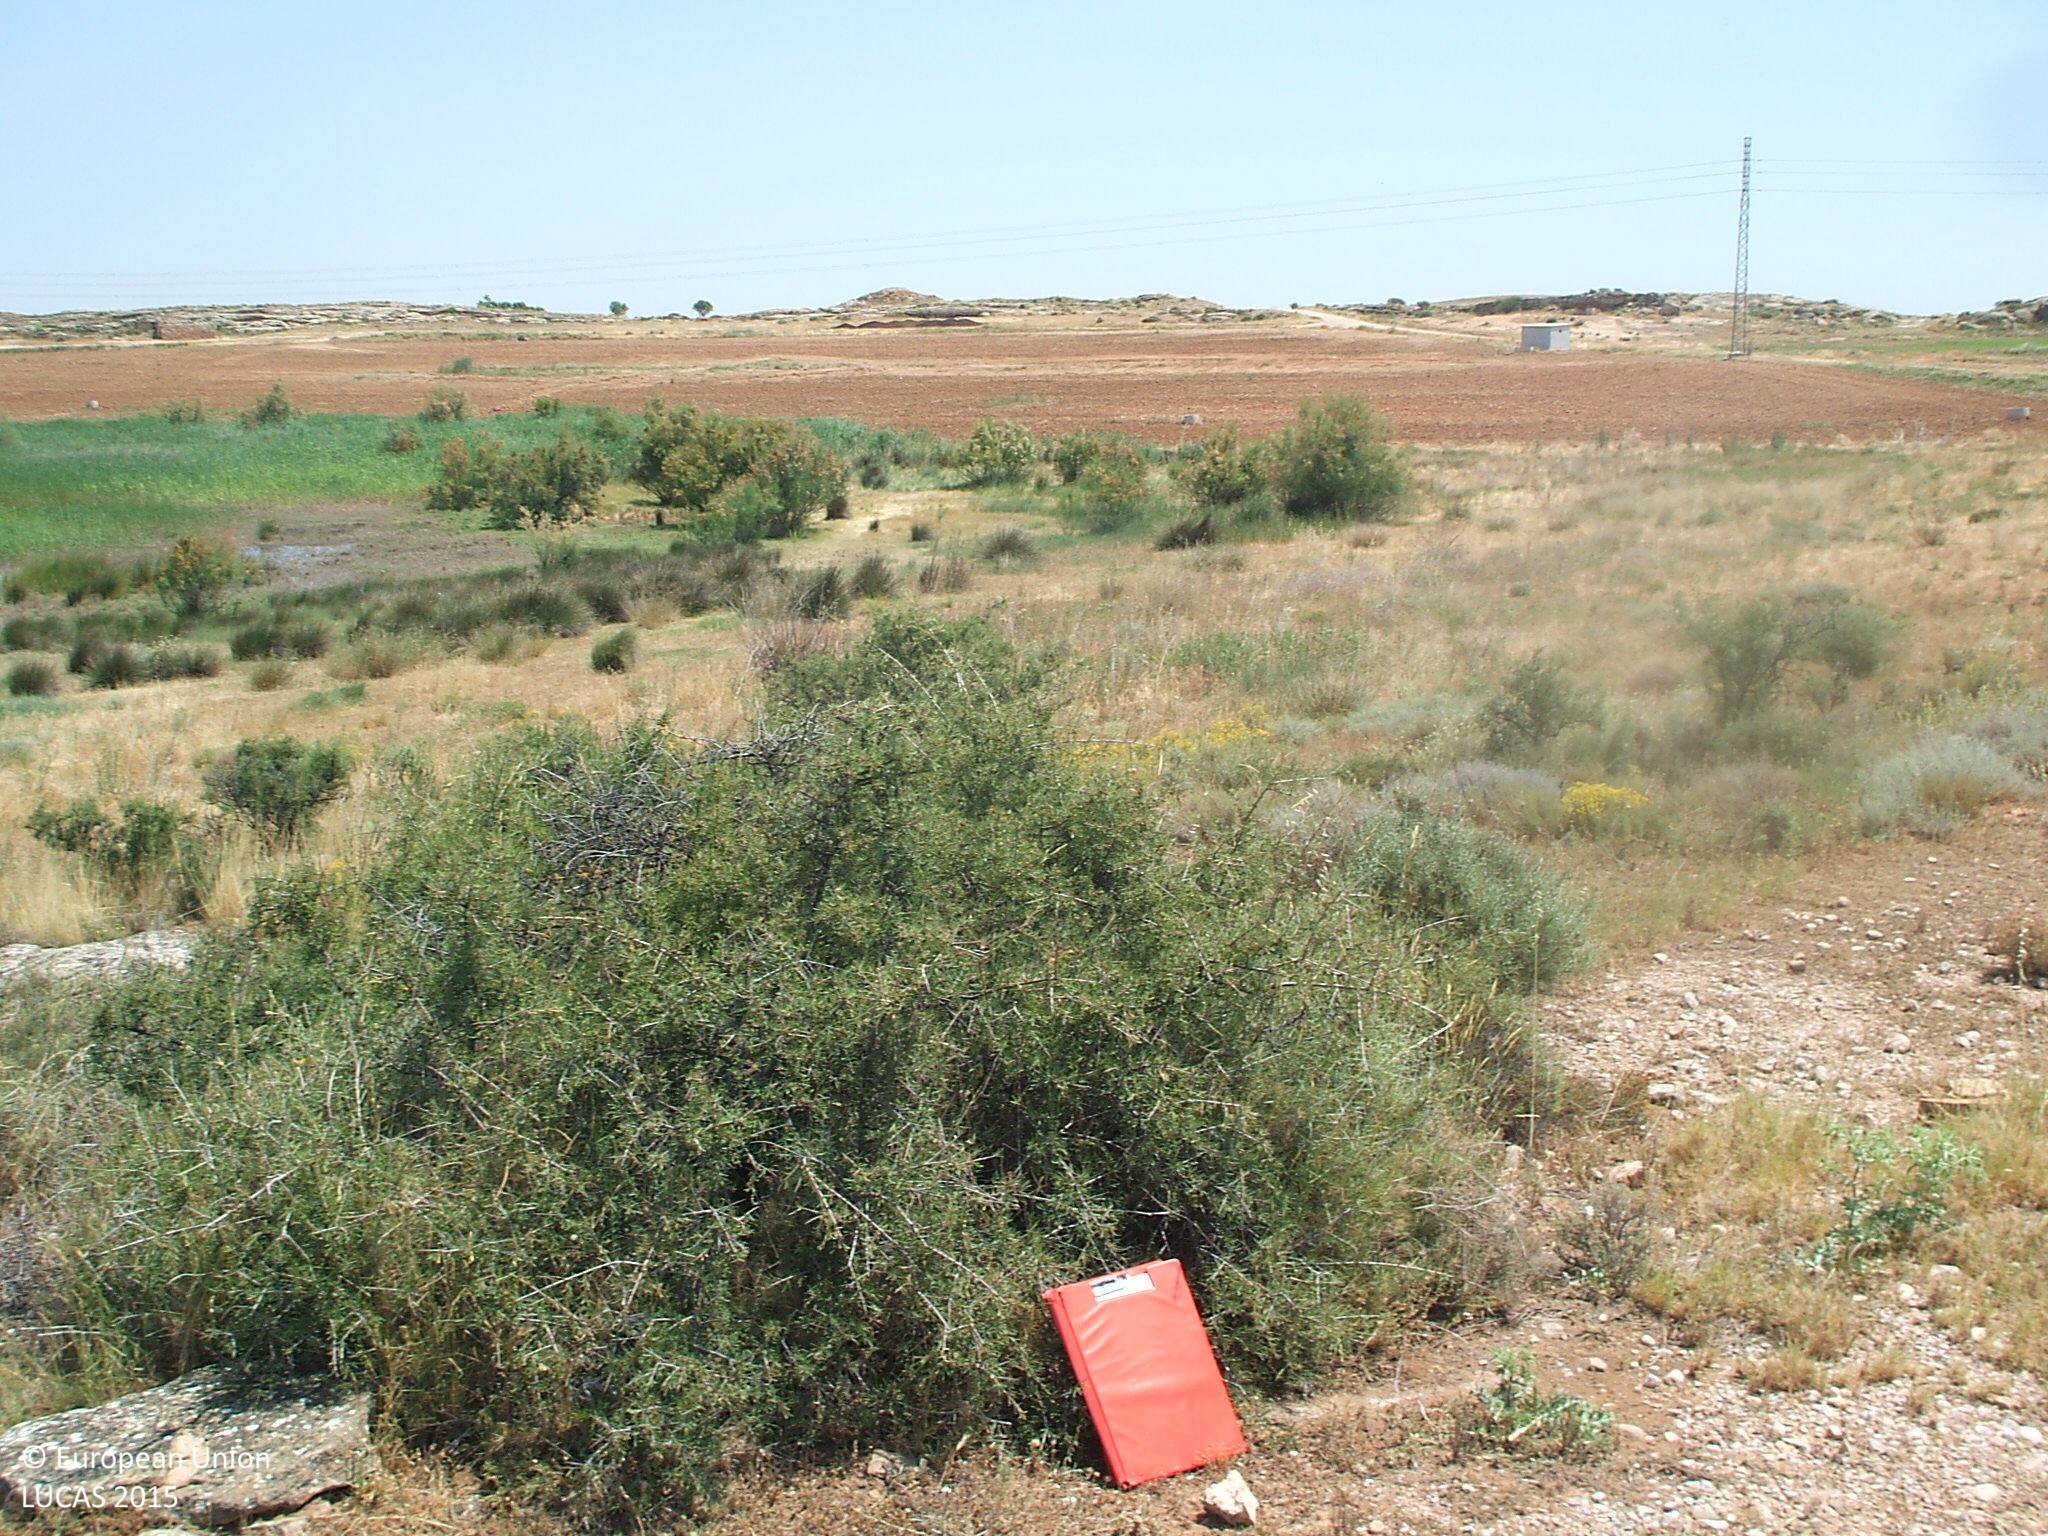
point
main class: Shrubland
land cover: Shrubland without tree cover
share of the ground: > 75 %
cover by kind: shrubs 90 %, herbaceous plants 10 %
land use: Semi-natural and natural areas not in use
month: June
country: ES
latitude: 41.0476
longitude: -0.1836
